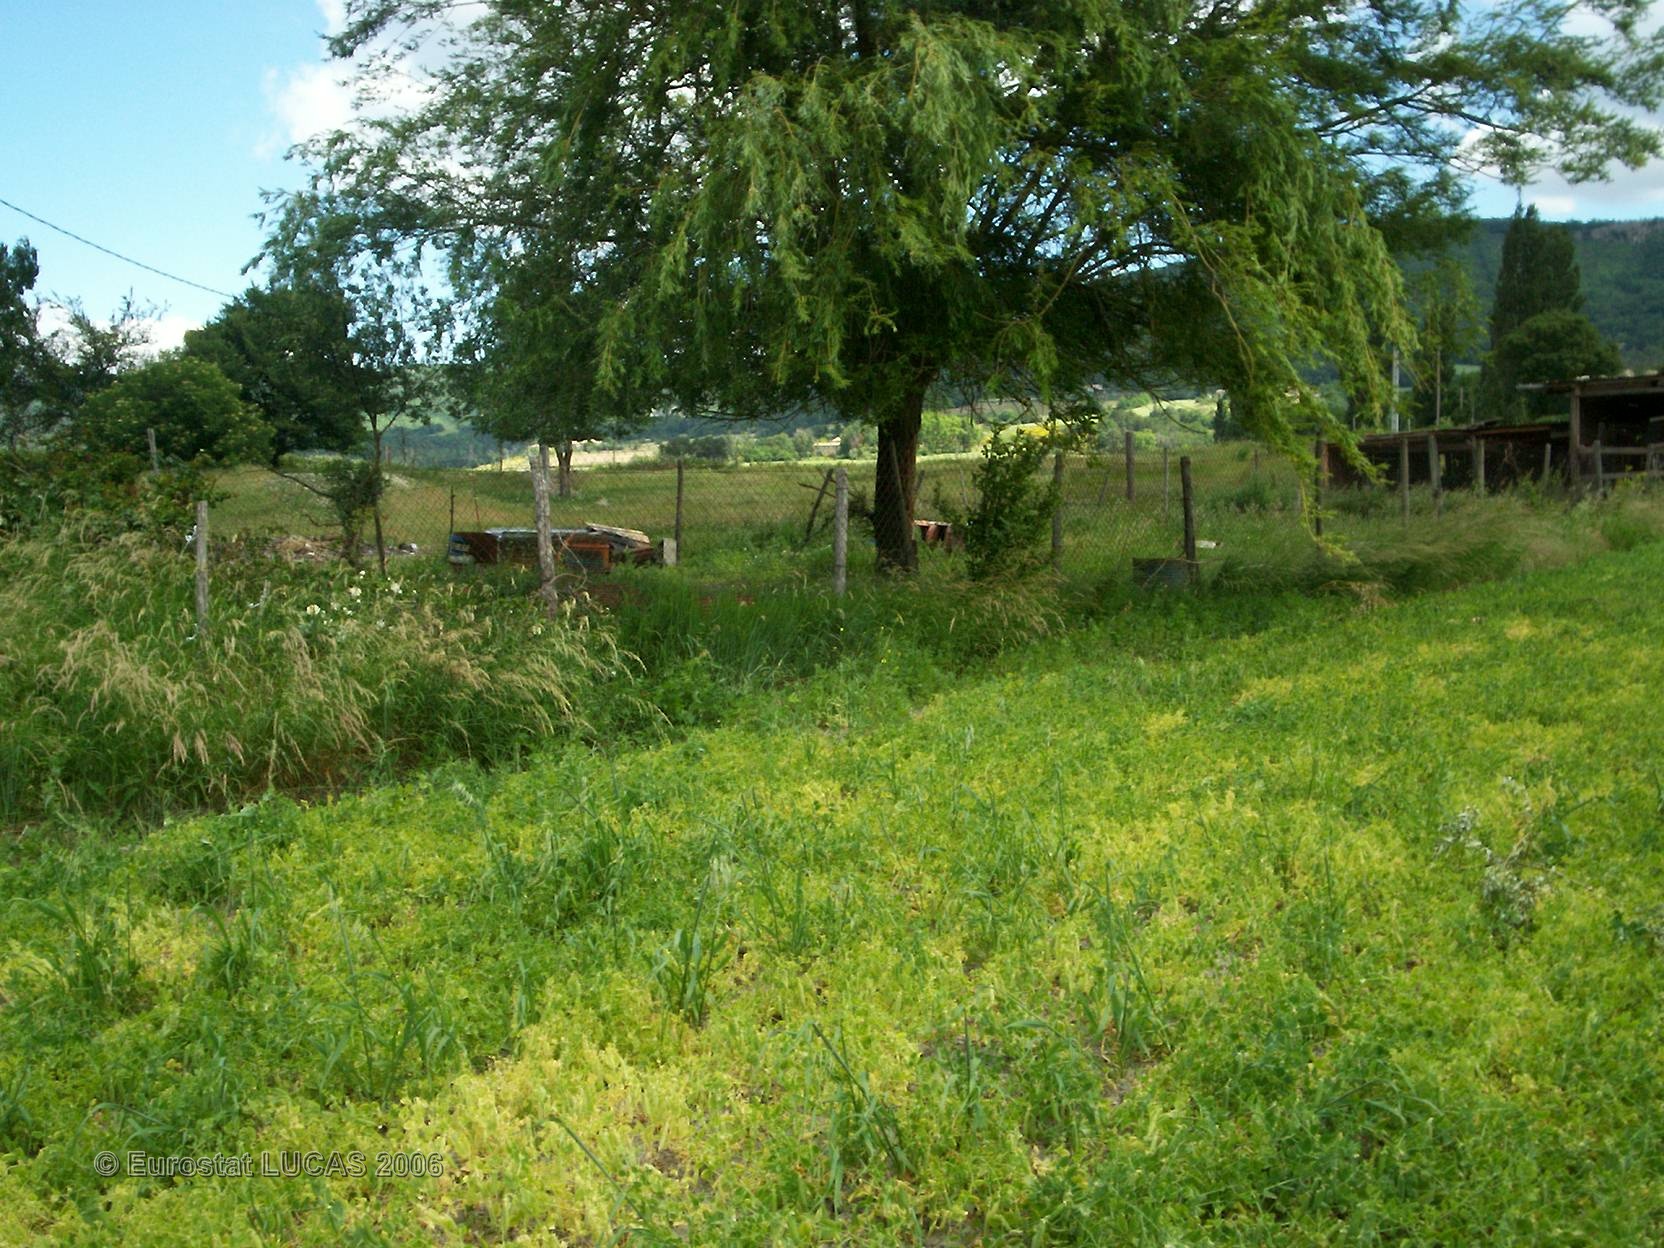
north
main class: Cropland
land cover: Dry pulses
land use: Agriculture (excluding fallow land and kitchen gardens)
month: May
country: FR
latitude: 44.6420
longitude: 4.9257
